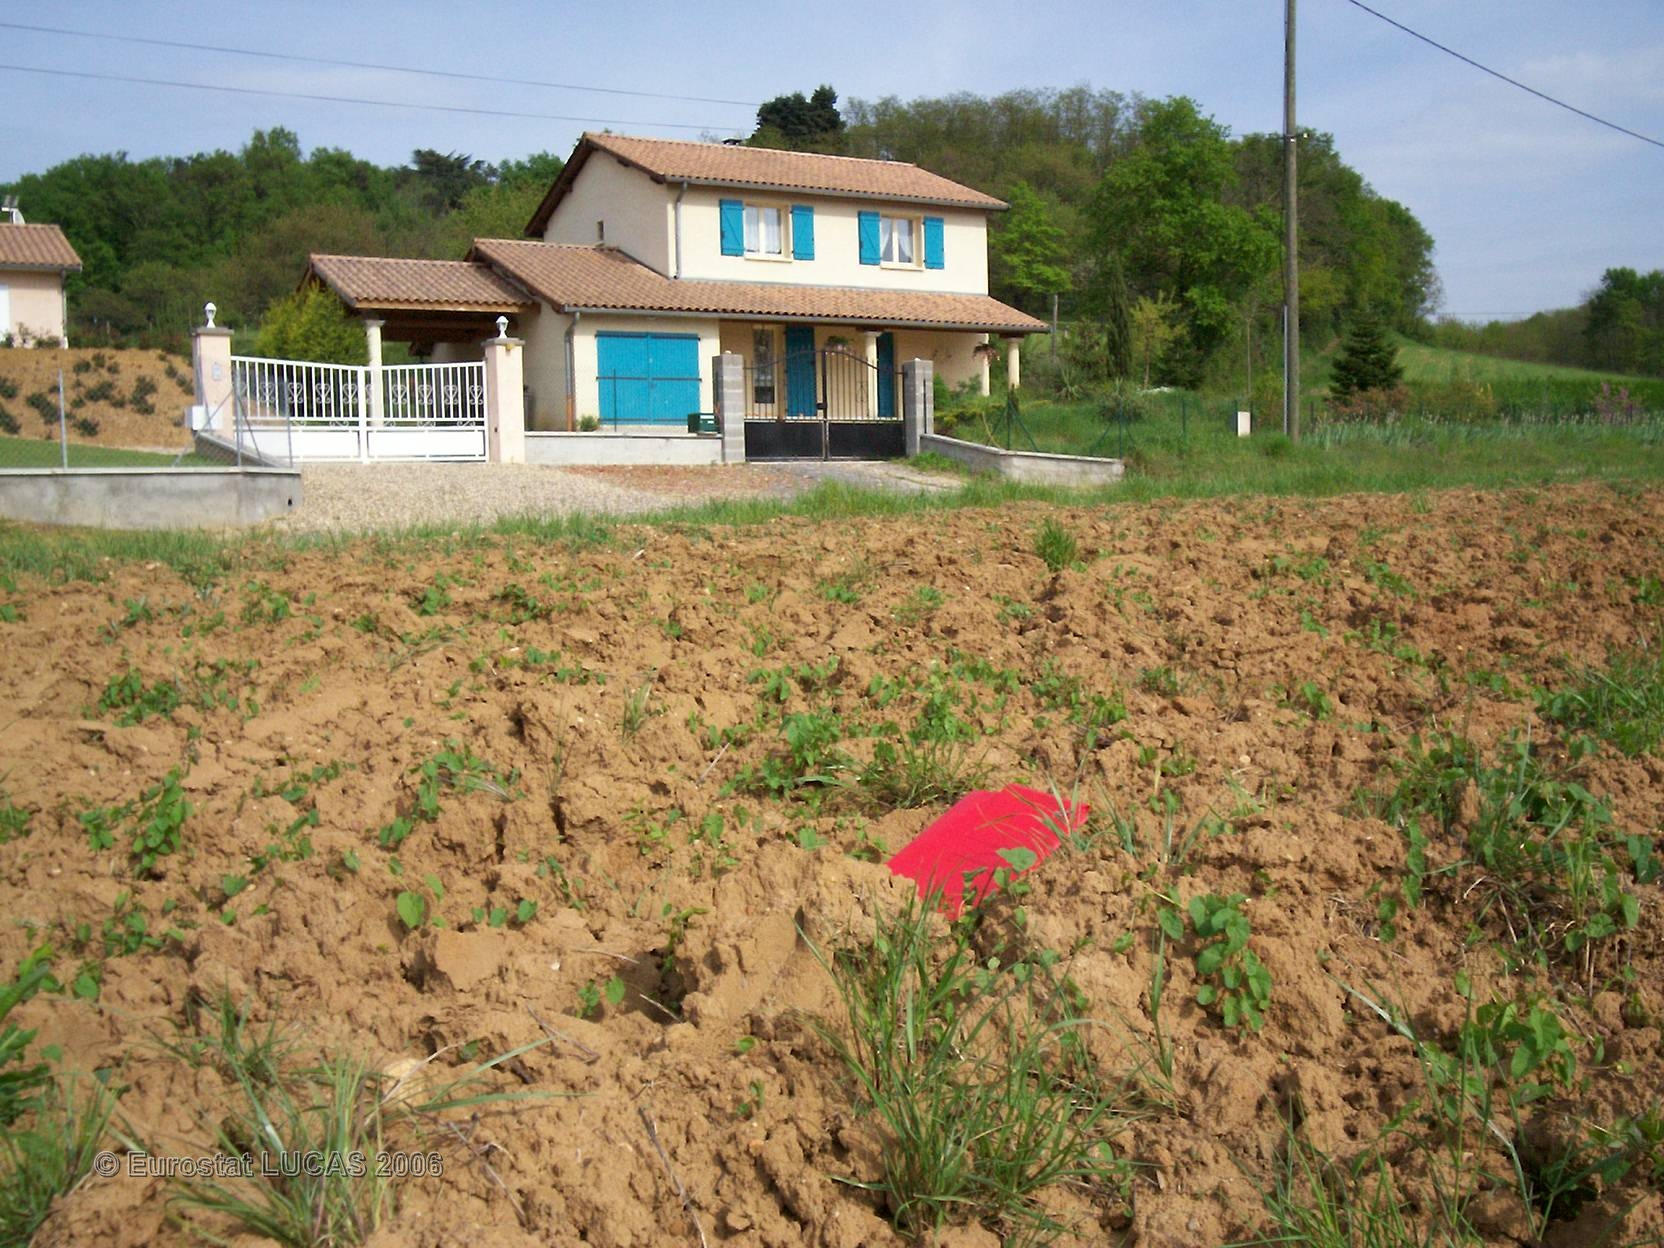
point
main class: Cropland
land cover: Maize
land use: Agriculture (excluding fallow land and kitchen gardens)
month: June
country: FR
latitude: 45.9529
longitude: 4.7779
